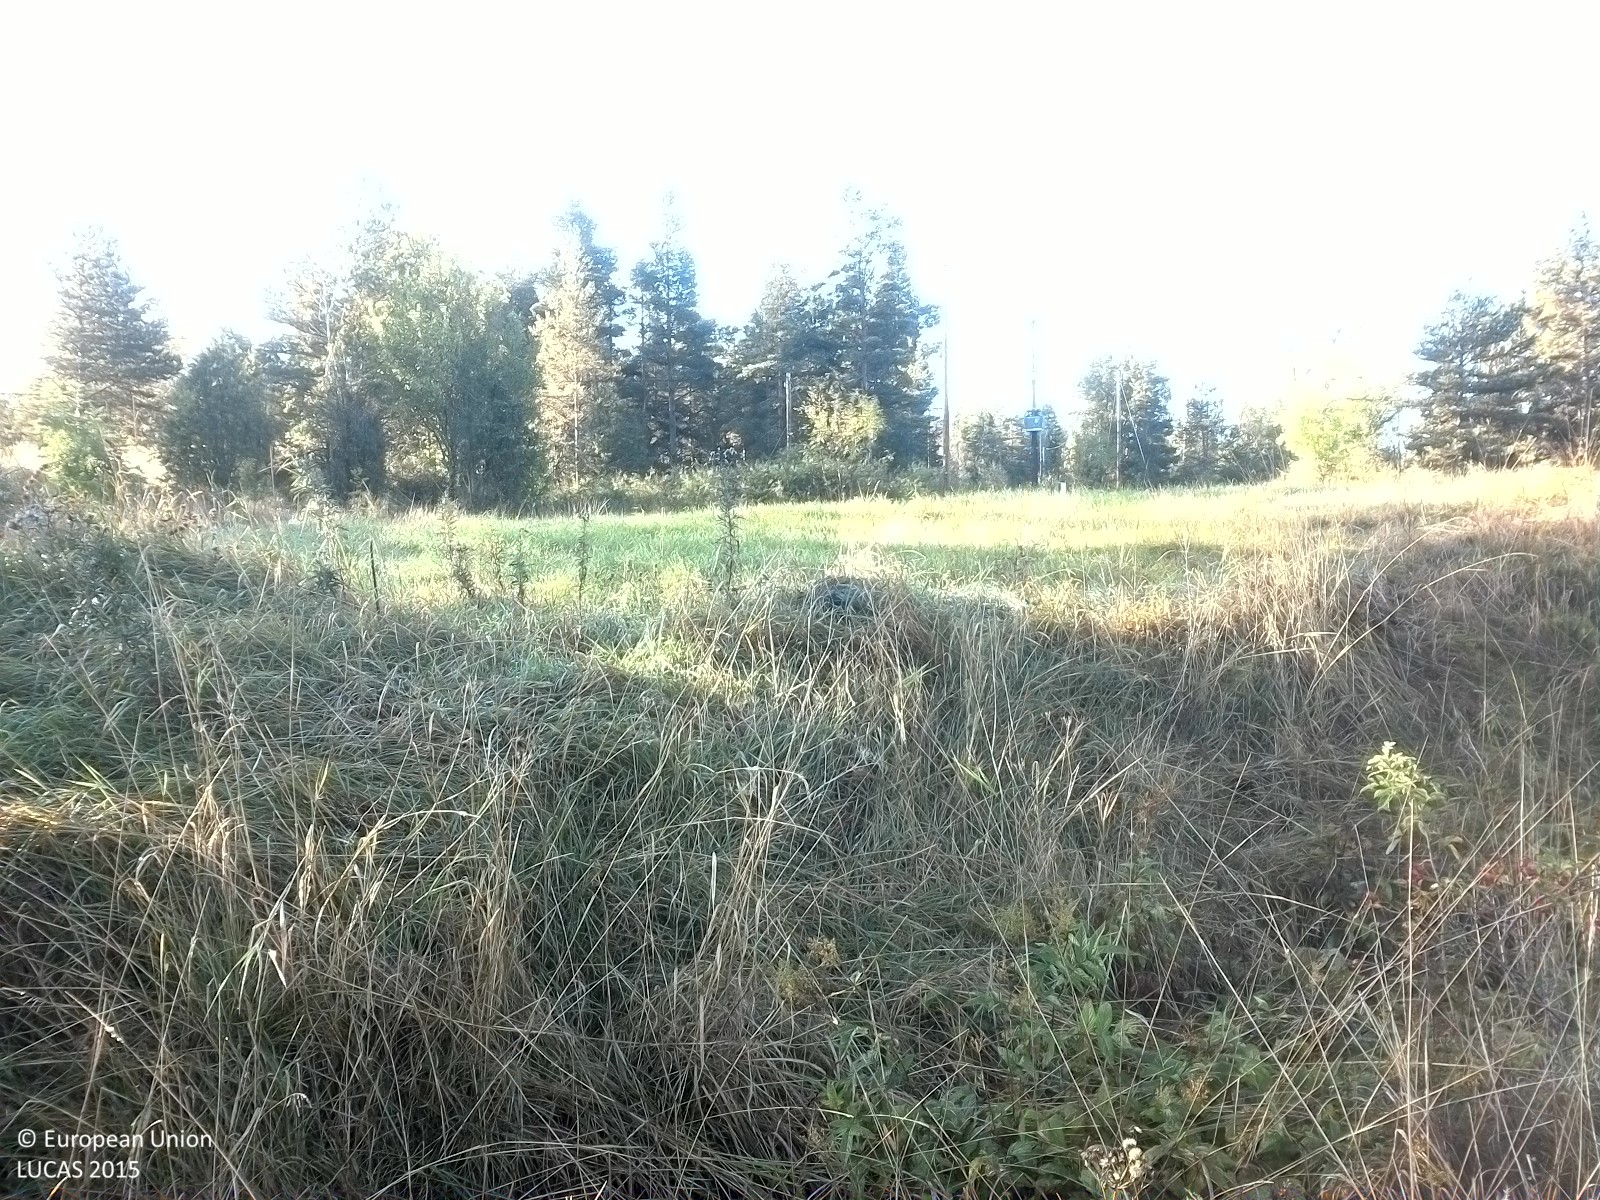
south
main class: Grassland
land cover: Grassland without tree/shrub cover
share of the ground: > 75 %
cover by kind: herbaceous plants 100 %
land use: Agriculture (excluding fallow land and kitchen gardens)
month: September
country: SE
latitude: 58.4840
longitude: 16.7373
